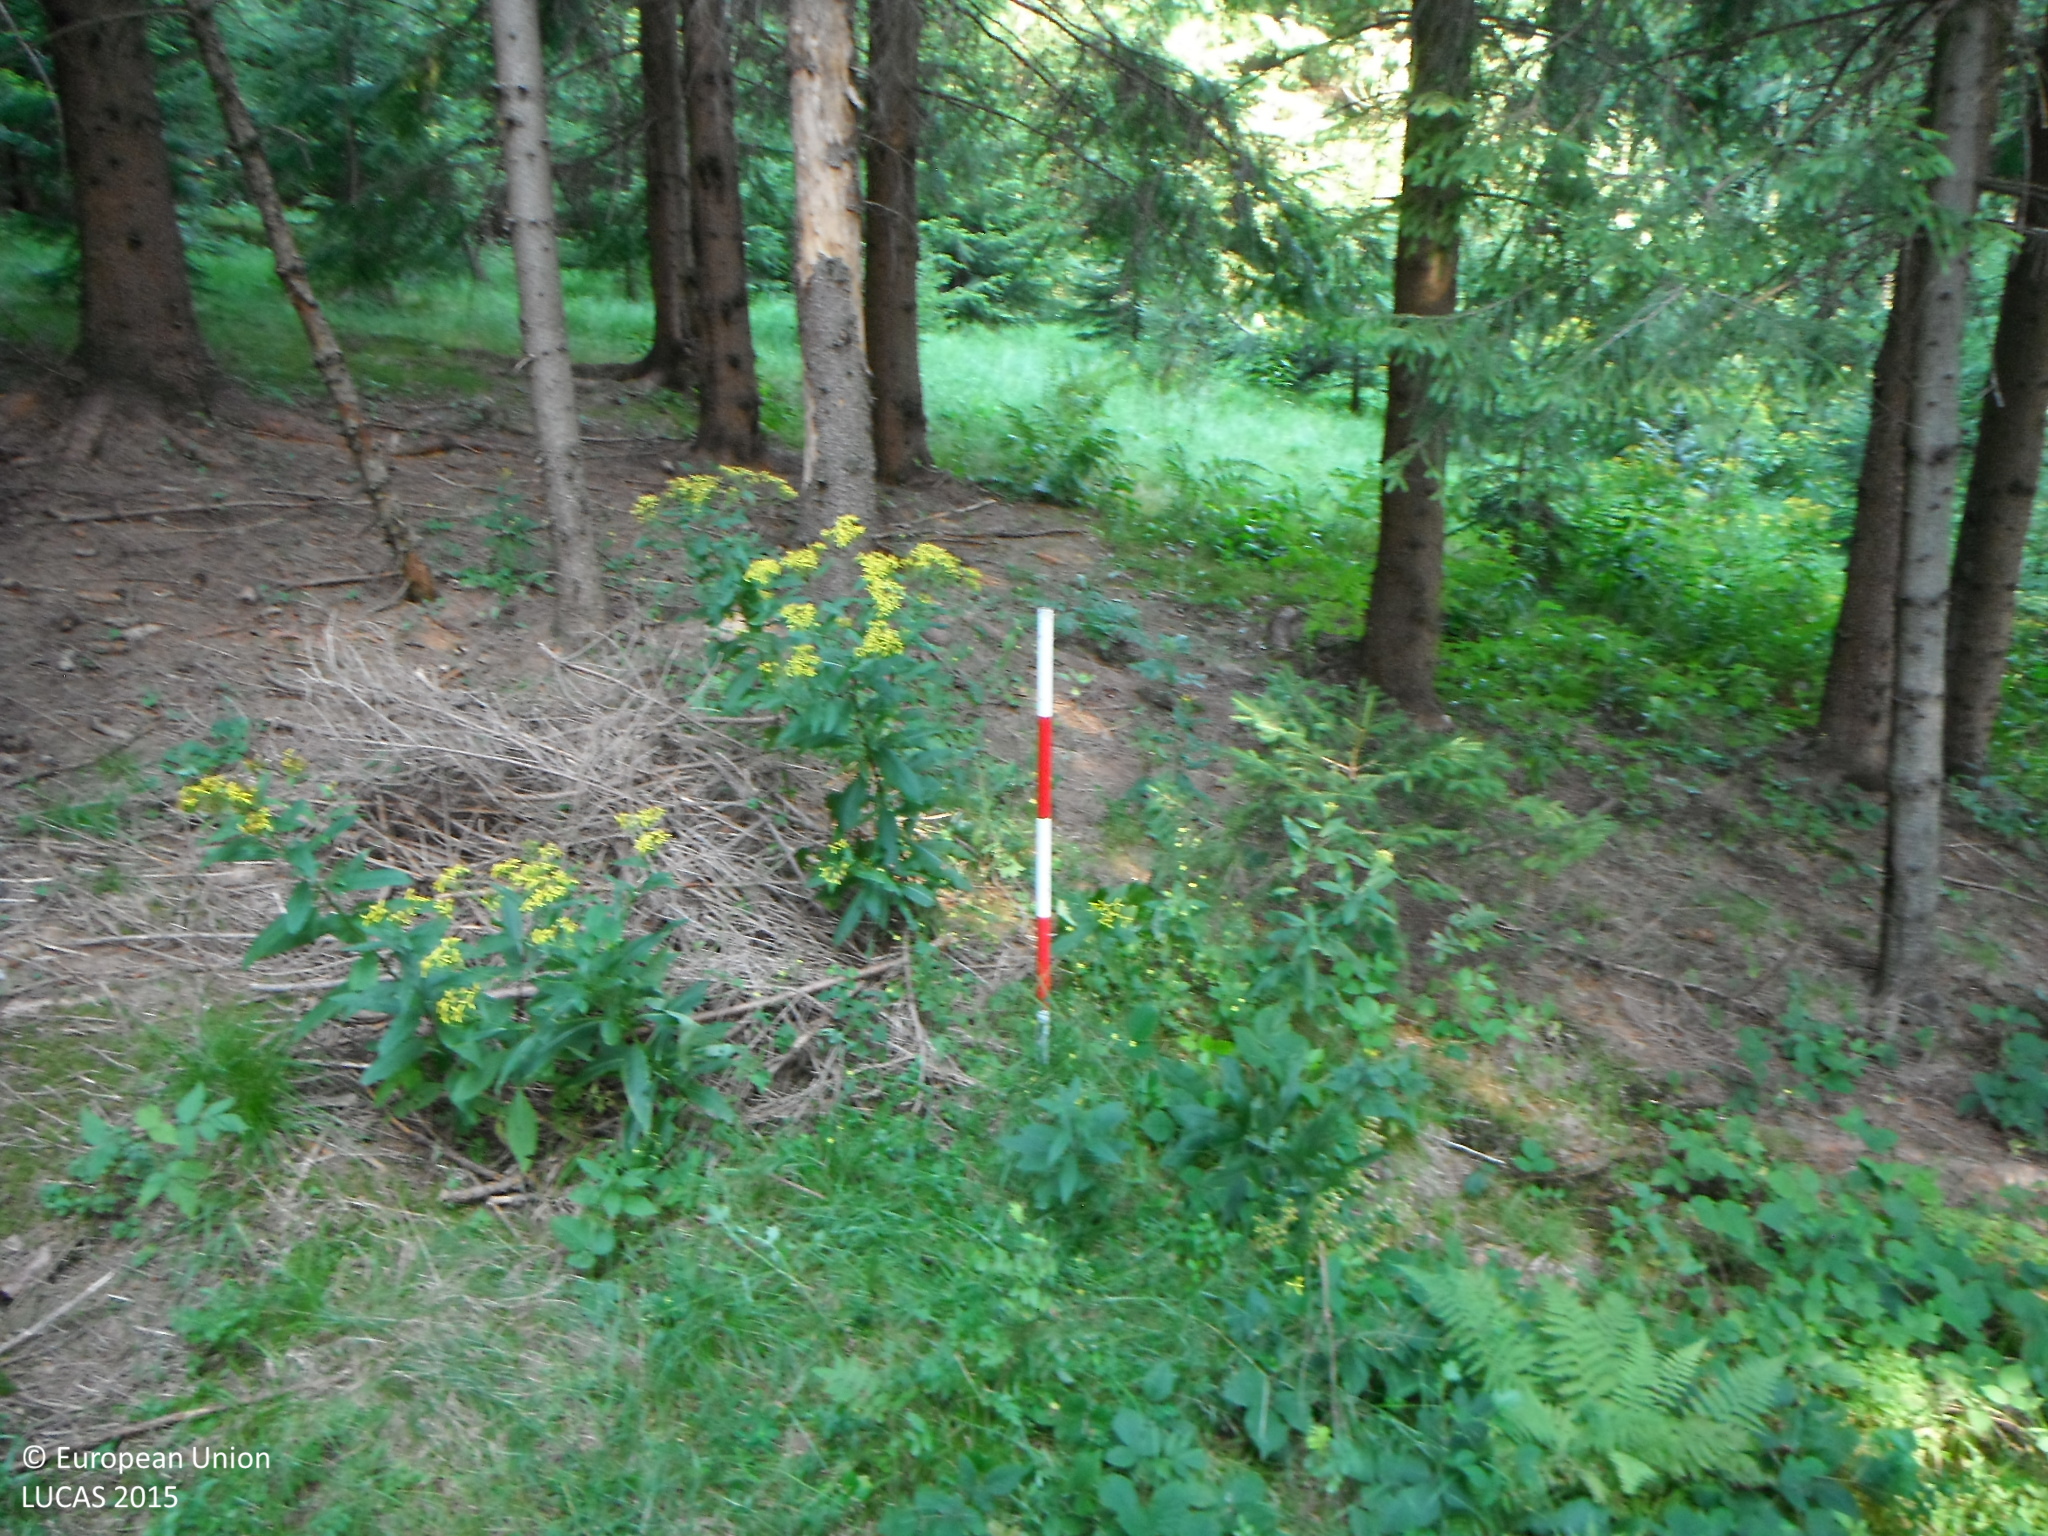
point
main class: Woodland
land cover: Spruce dominated coniferous woodland
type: alpine coniferous forest
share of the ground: > 75 %
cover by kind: coniferous forest trees 95 %, herbaceous plants 5 %
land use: Forestry
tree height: > 5 m
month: August
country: SK
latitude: 49.4741
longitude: 18.8953
